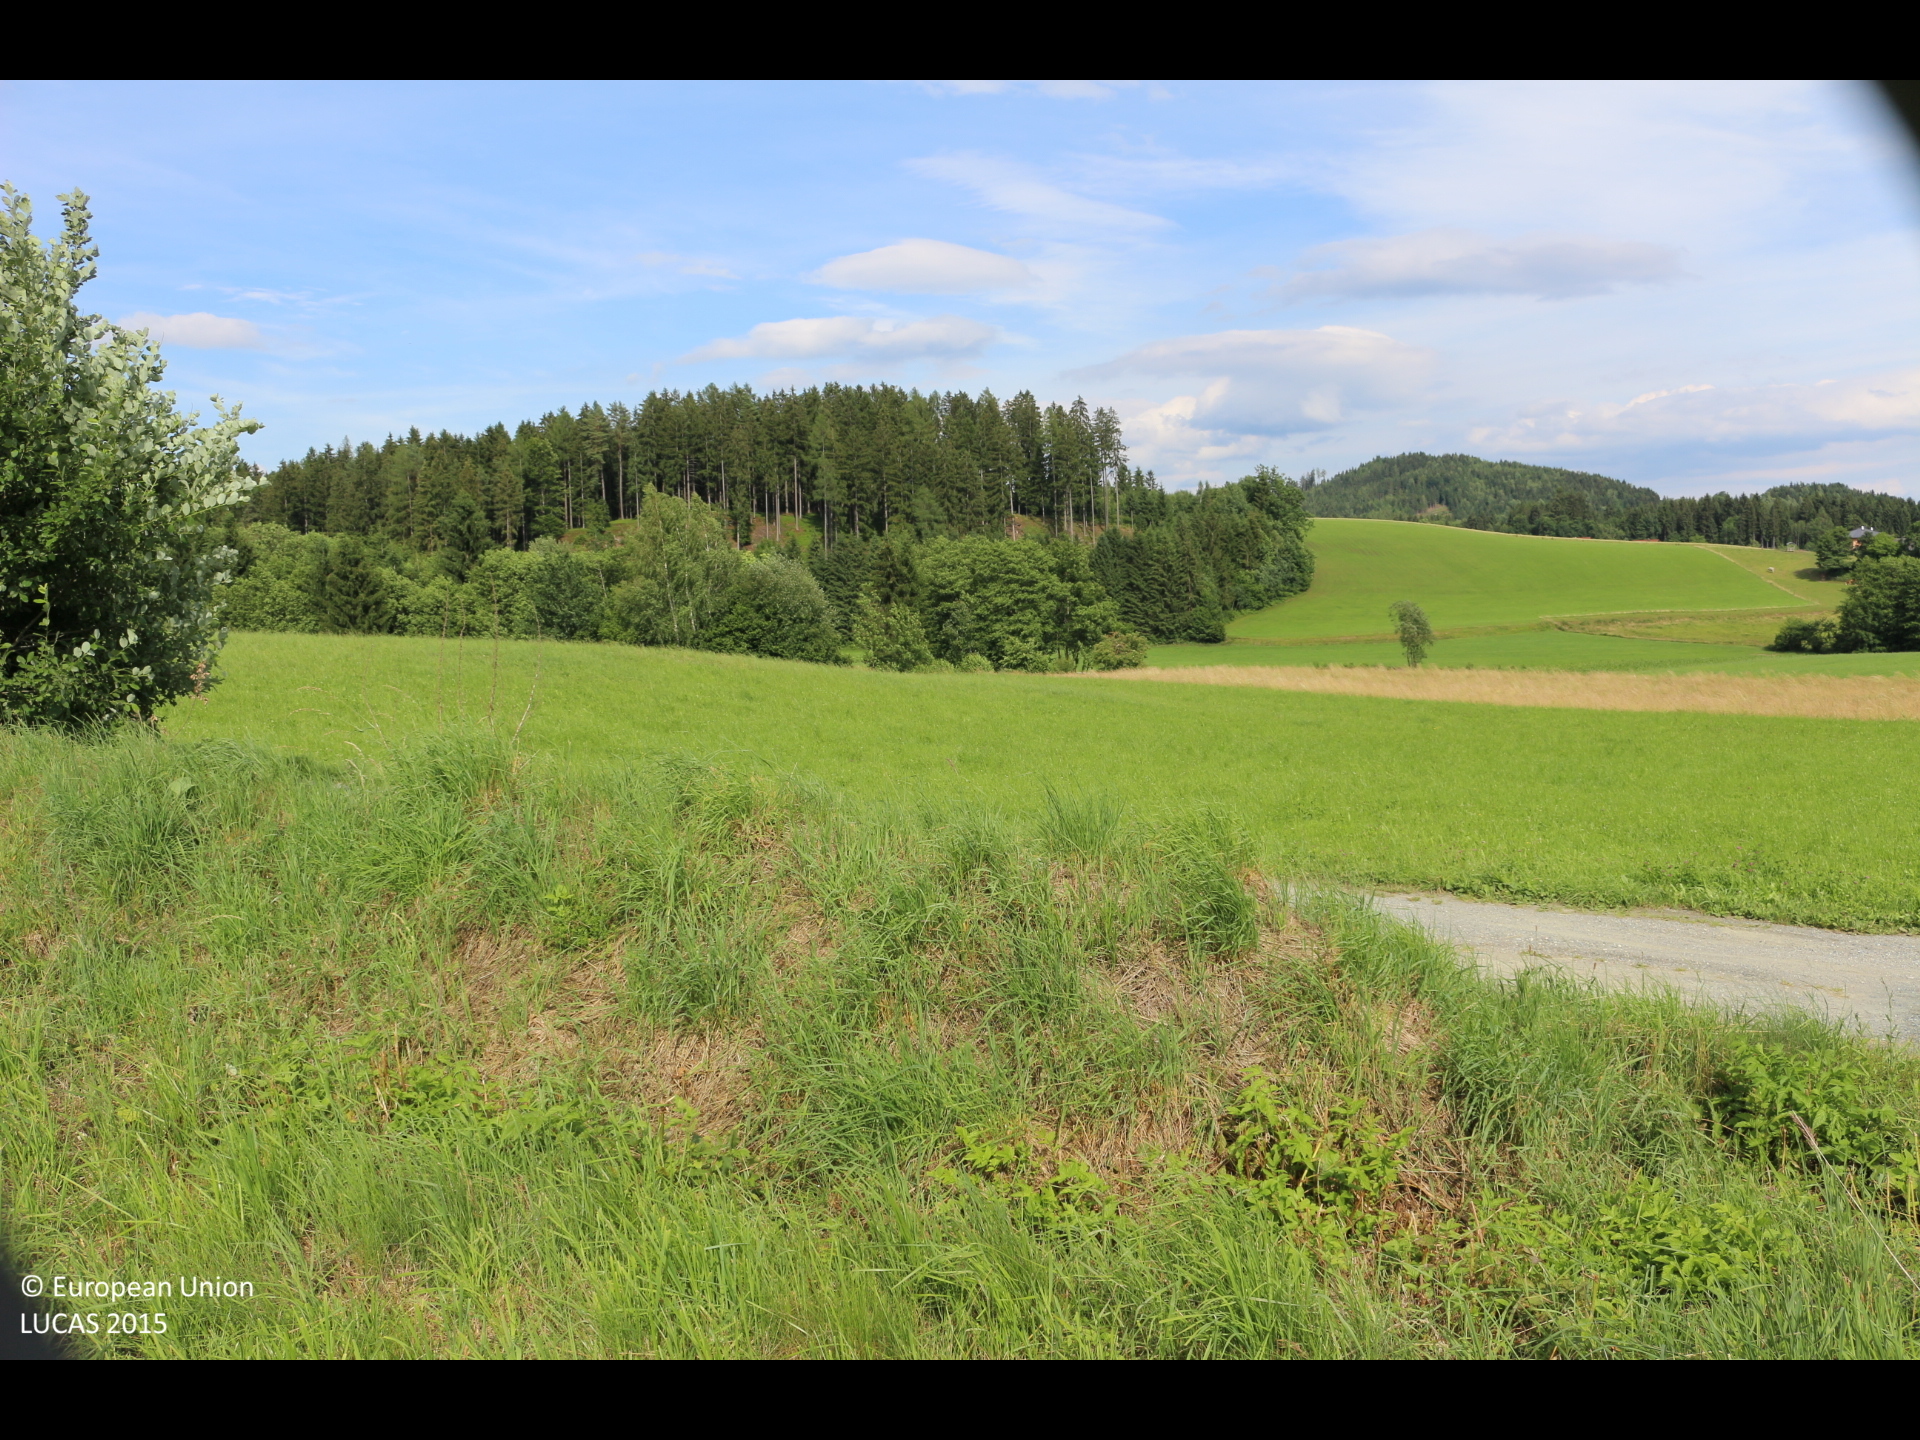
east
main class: Grassland
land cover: Grassland without tree/shrub cover
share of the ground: > 75 %
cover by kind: herbaceous plants 100 %
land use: Agriculture (excluding fallow land and kitchen gardens)
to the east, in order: Grassland without tree/shrub cover; Tracks; Grassland without tree/shrub cover; Maize; Grassland without tree/shrub cover; Broadleaved woodland; Rivers and streams; Broadleaved woodland; Grassland without tree/shrub cover
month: June
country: AT
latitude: 46.7257
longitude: 14.0406
